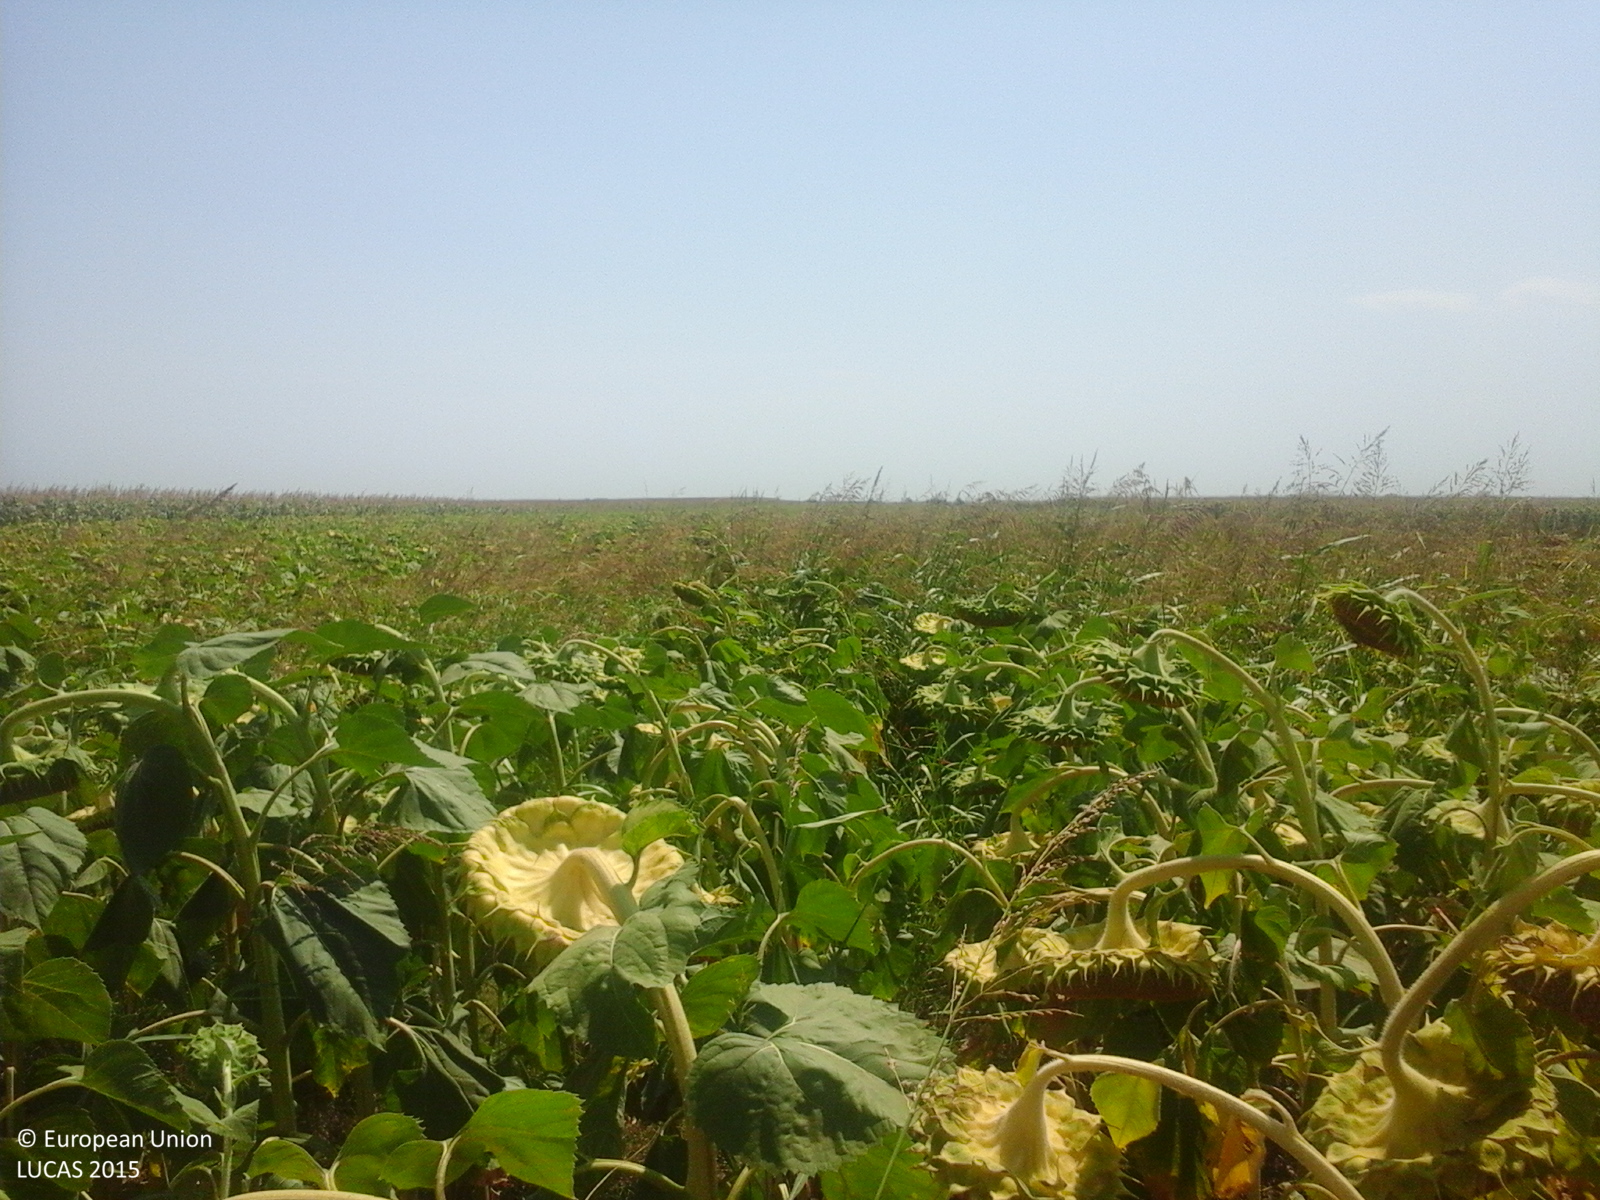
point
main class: Cropland
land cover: Sunflower
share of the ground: > 75 %
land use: Agriculture (excluding fallow land and kitchen gardens)
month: August
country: RO
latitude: 45.2163
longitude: 27.7697
